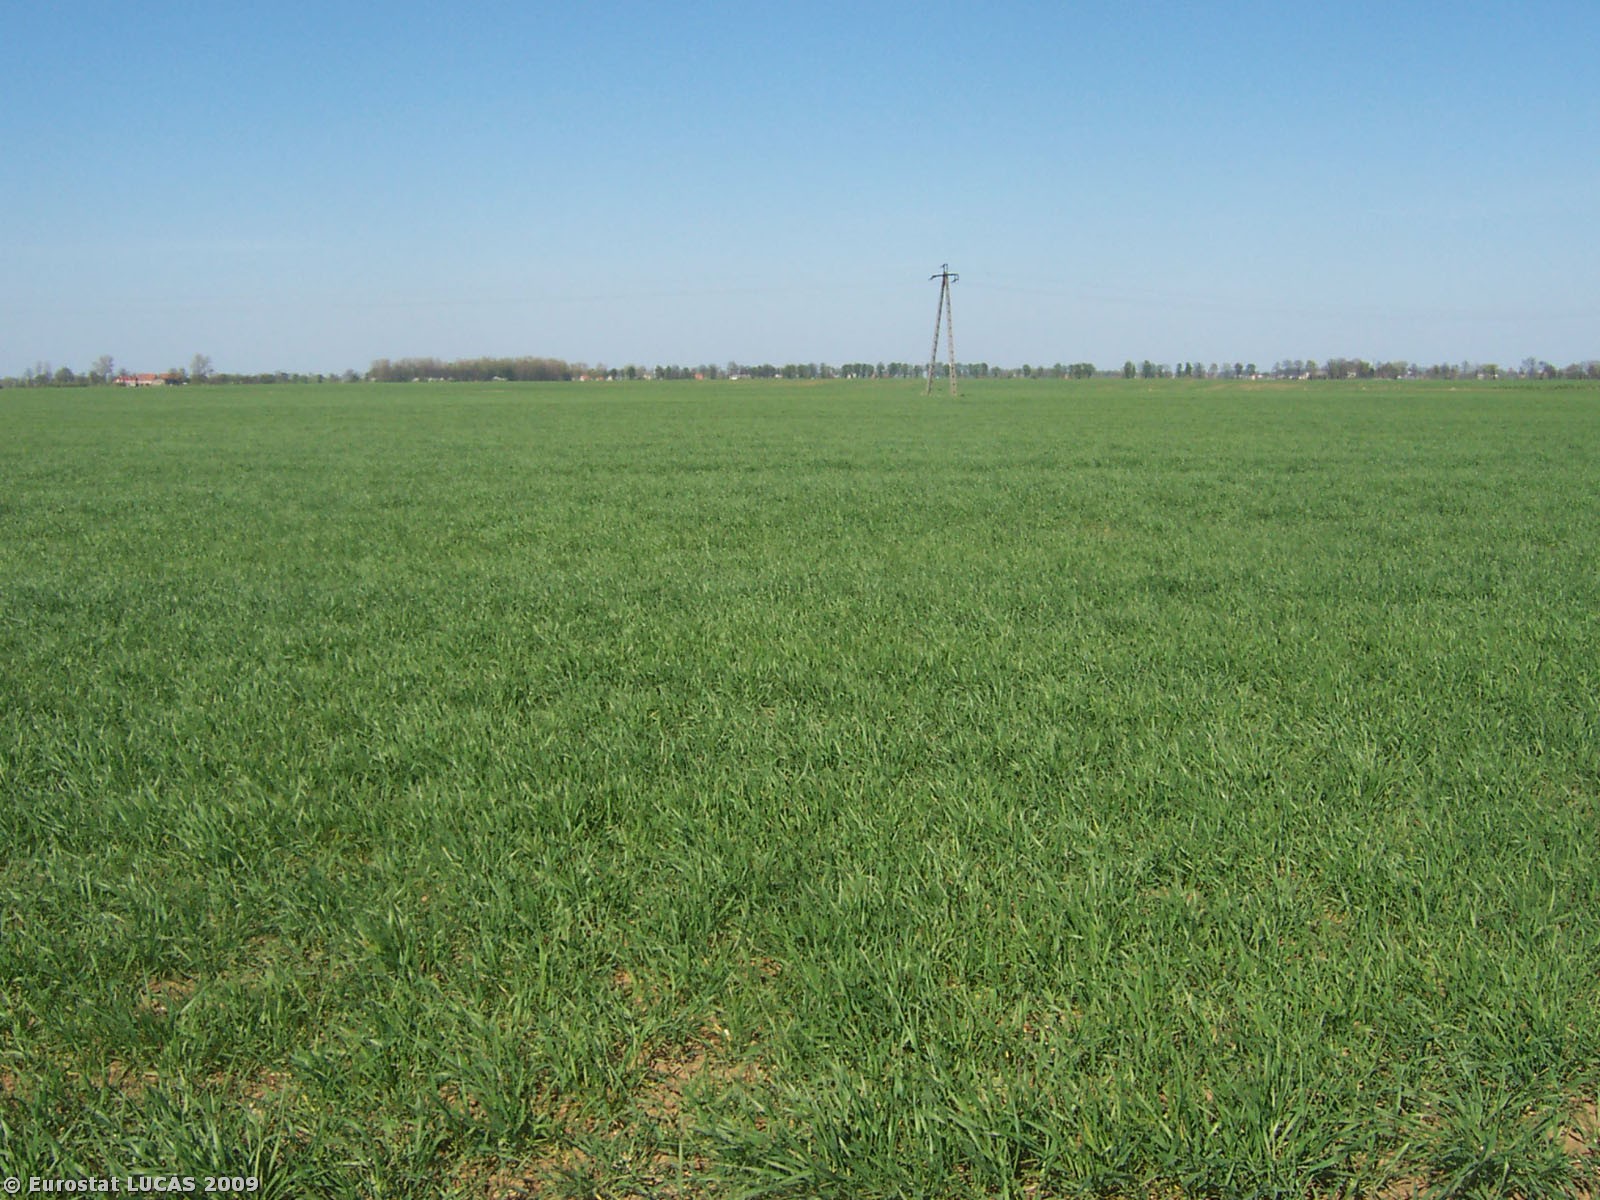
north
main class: Cropland
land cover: Common wheat
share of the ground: 25 - 50 %
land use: Agriculture (excluding fallow land and kitchen gardens)
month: April
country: PL
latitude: 54.1000
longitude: 18.9672
